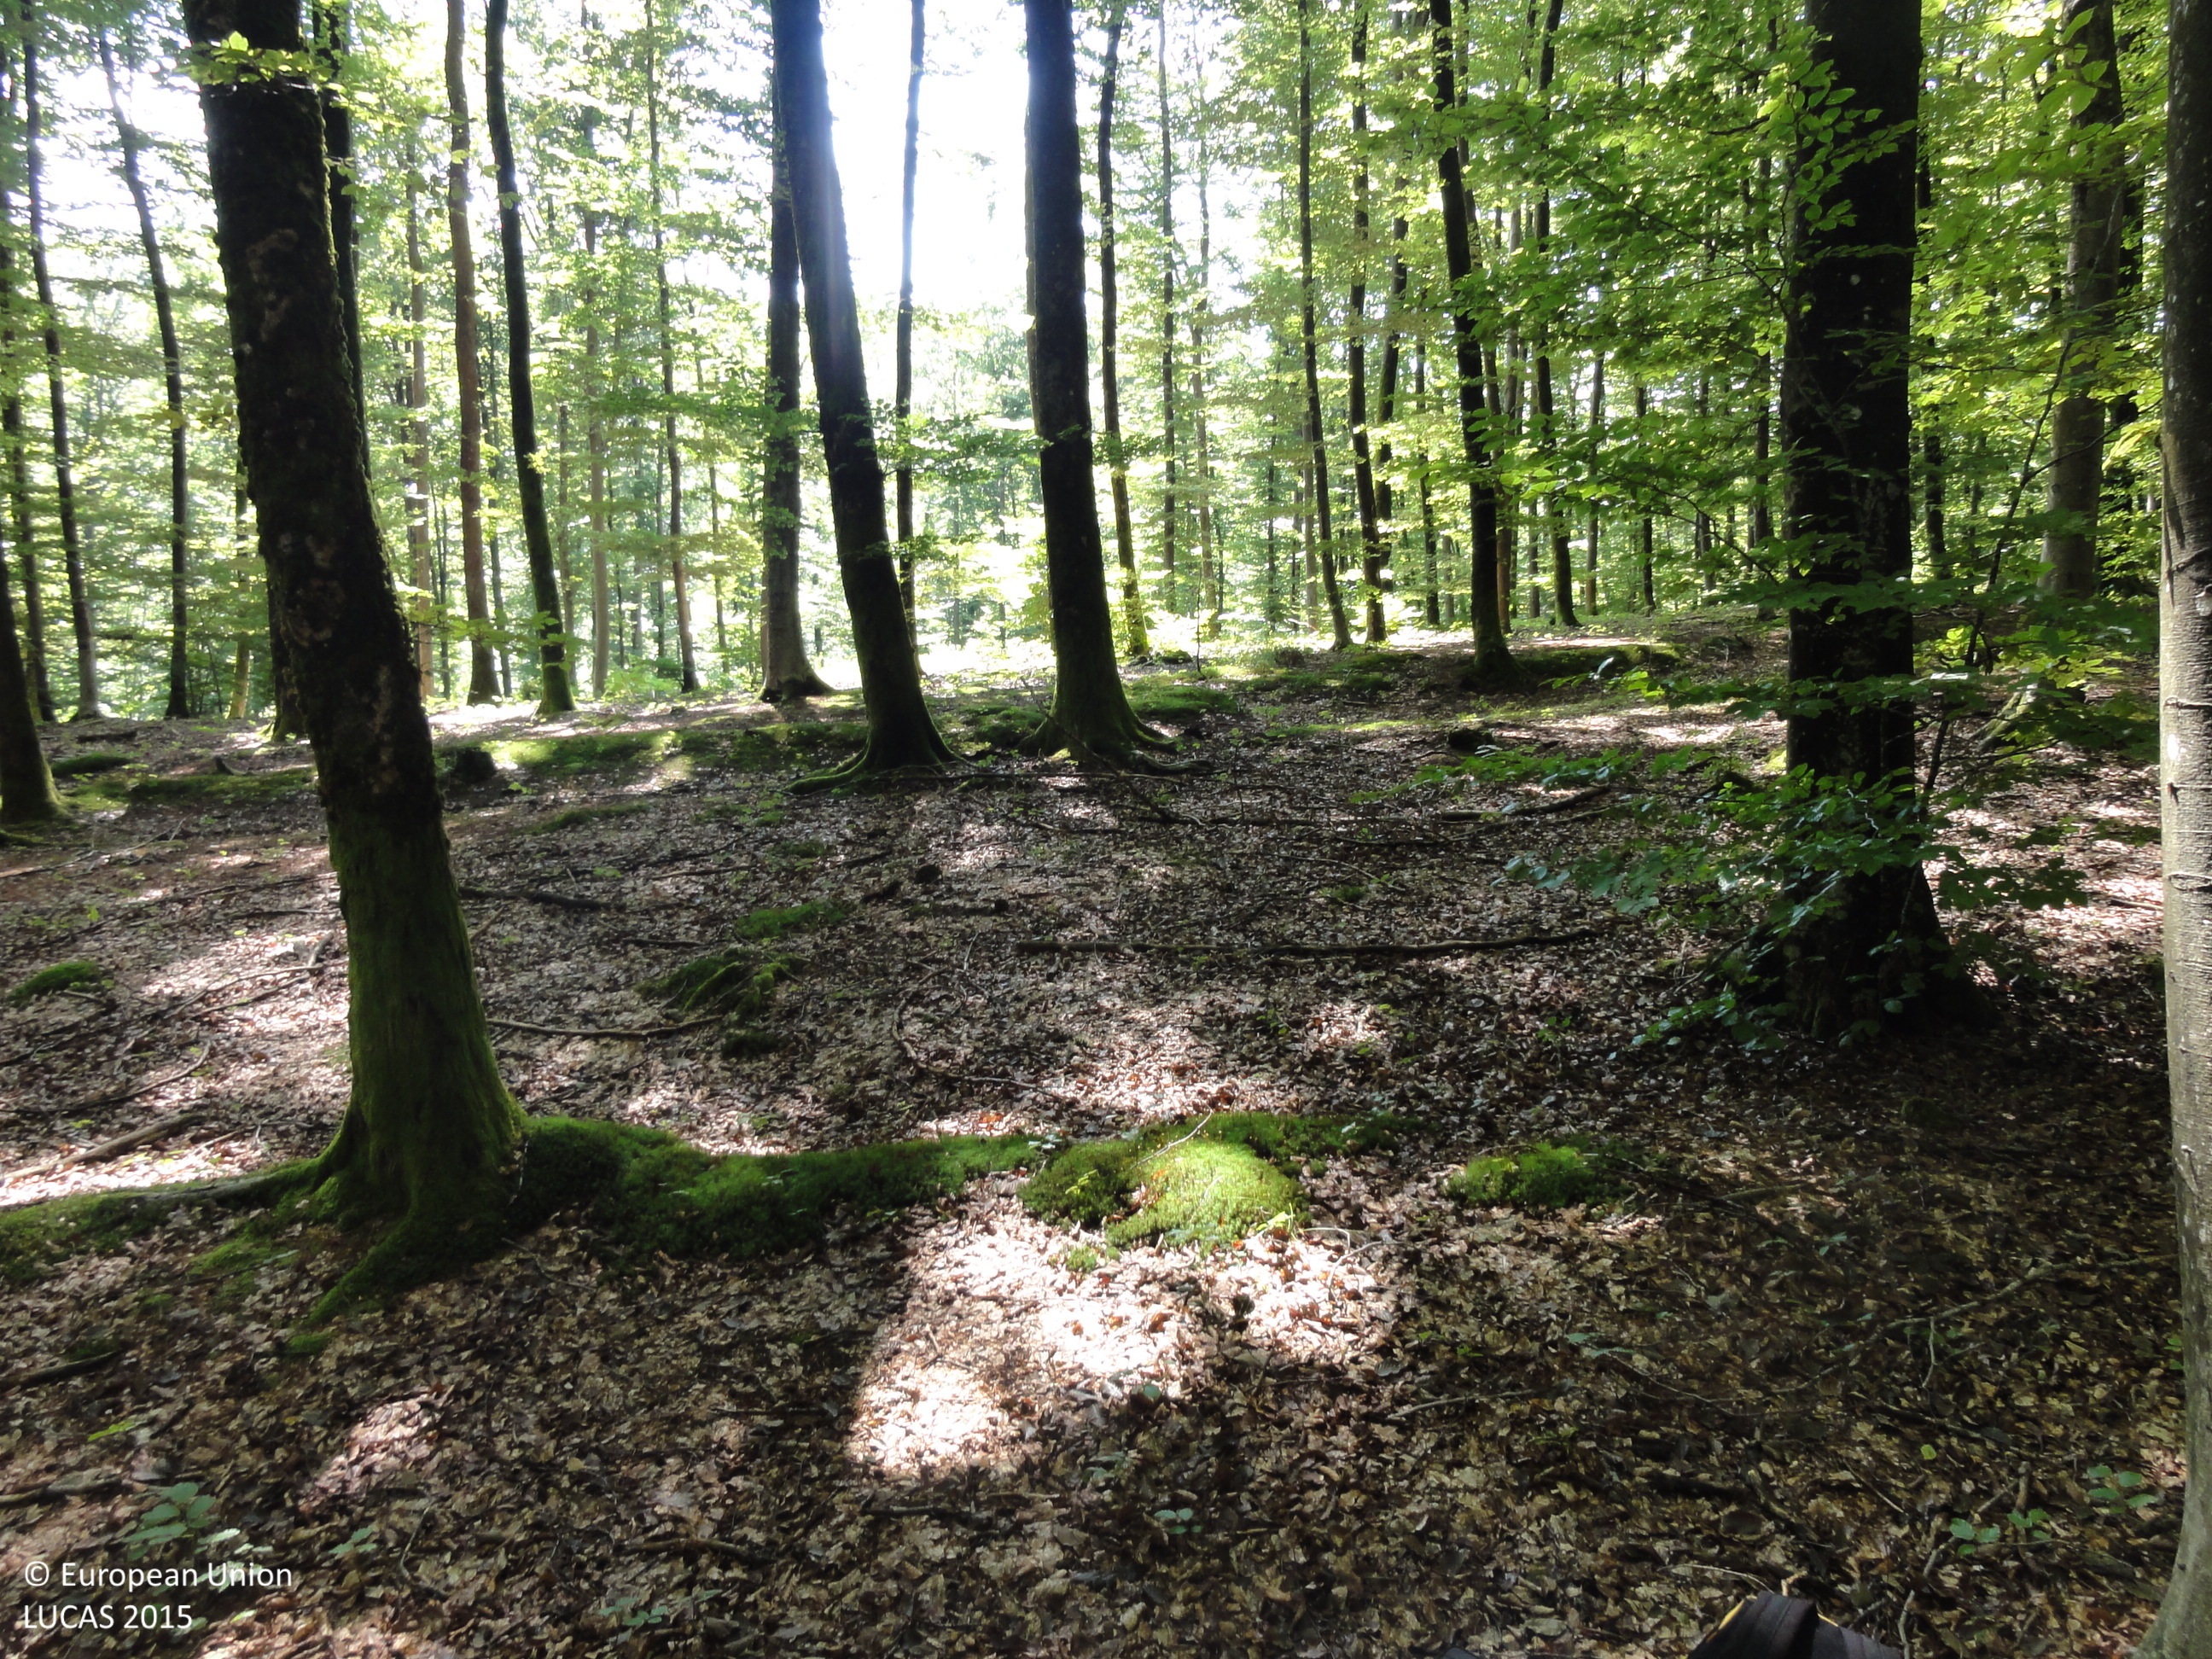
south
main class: Woodland
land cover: Broadleaved woodland
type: beech forest
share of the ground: > 75 %
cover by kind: broadleaved forest trees 100 %
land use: Forestry
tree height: > 5 m
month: August
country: SI
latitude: 46.0068
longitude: 15.2273
